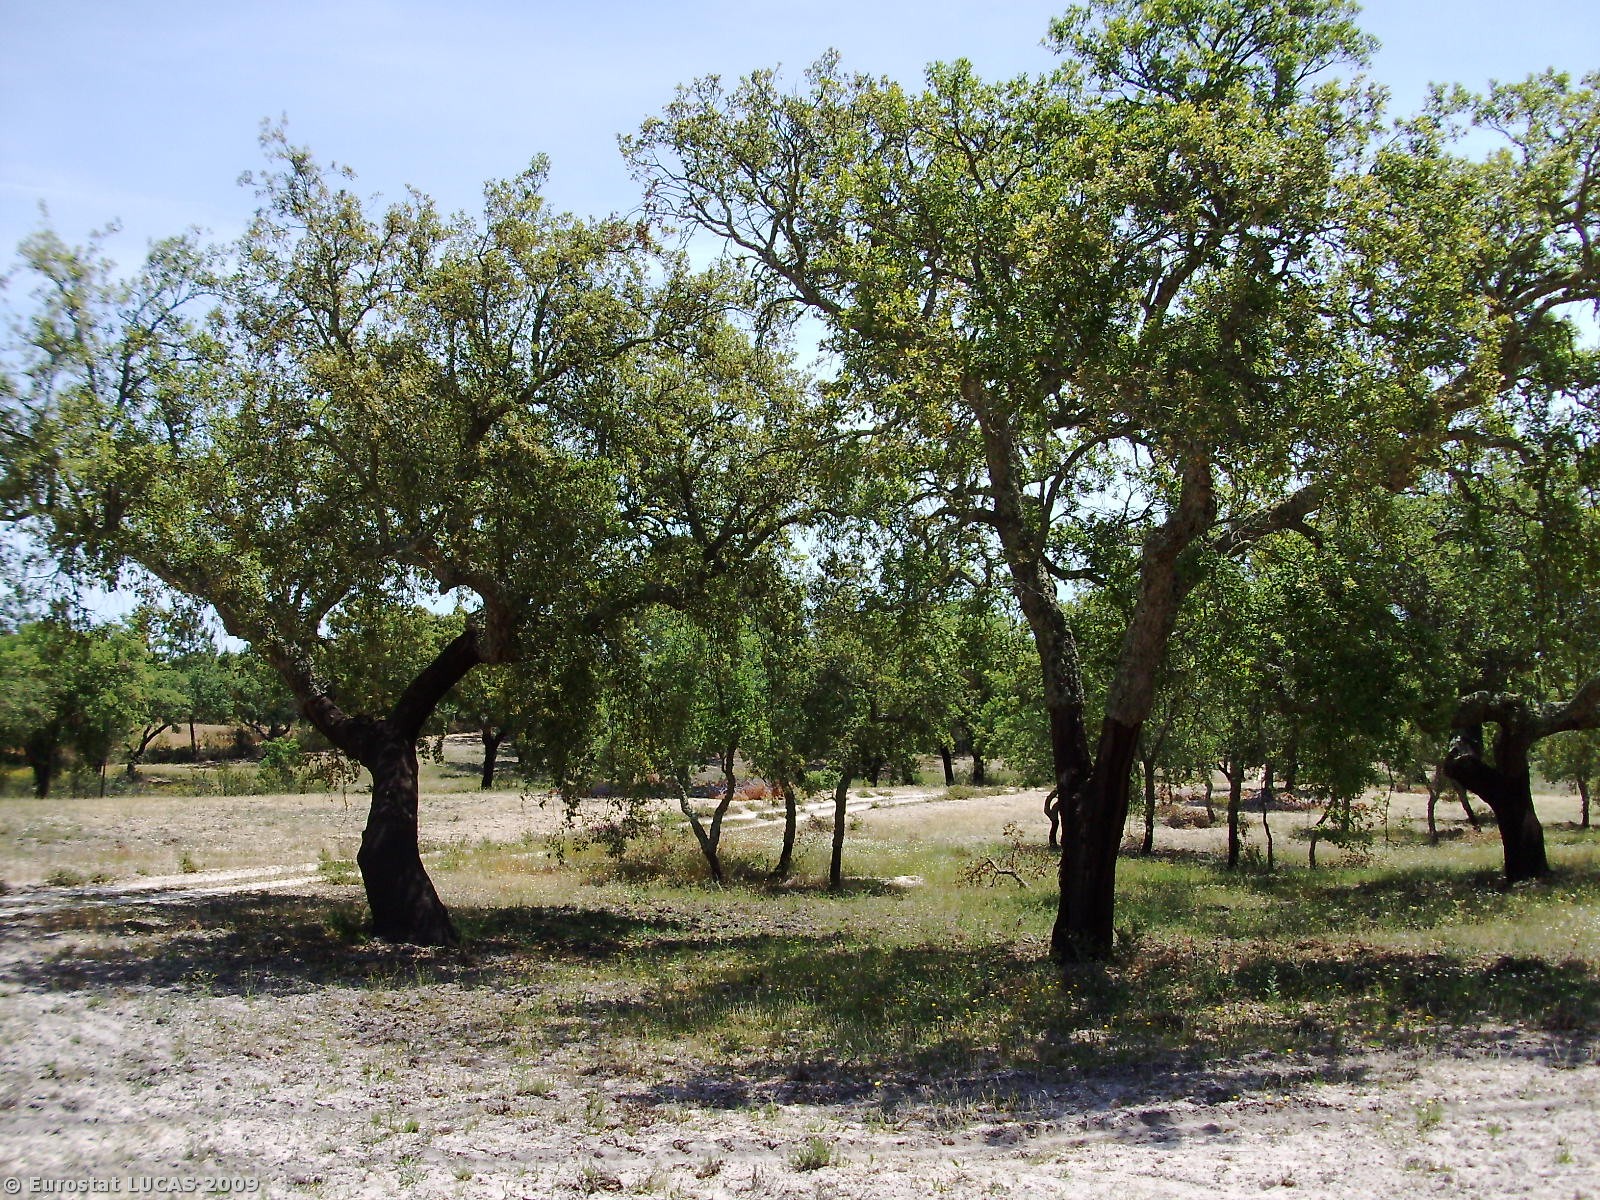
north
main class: Woodland
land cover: Broadleaved woodland
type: broadleaved evergreen forest
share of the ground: 50 - 75 %
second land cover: Bare land
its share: 25 - 50 %
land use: Forestry
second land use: Fallow land
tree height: > 5 m
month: May
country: PT
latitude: 39.1553
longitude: -8.0248
